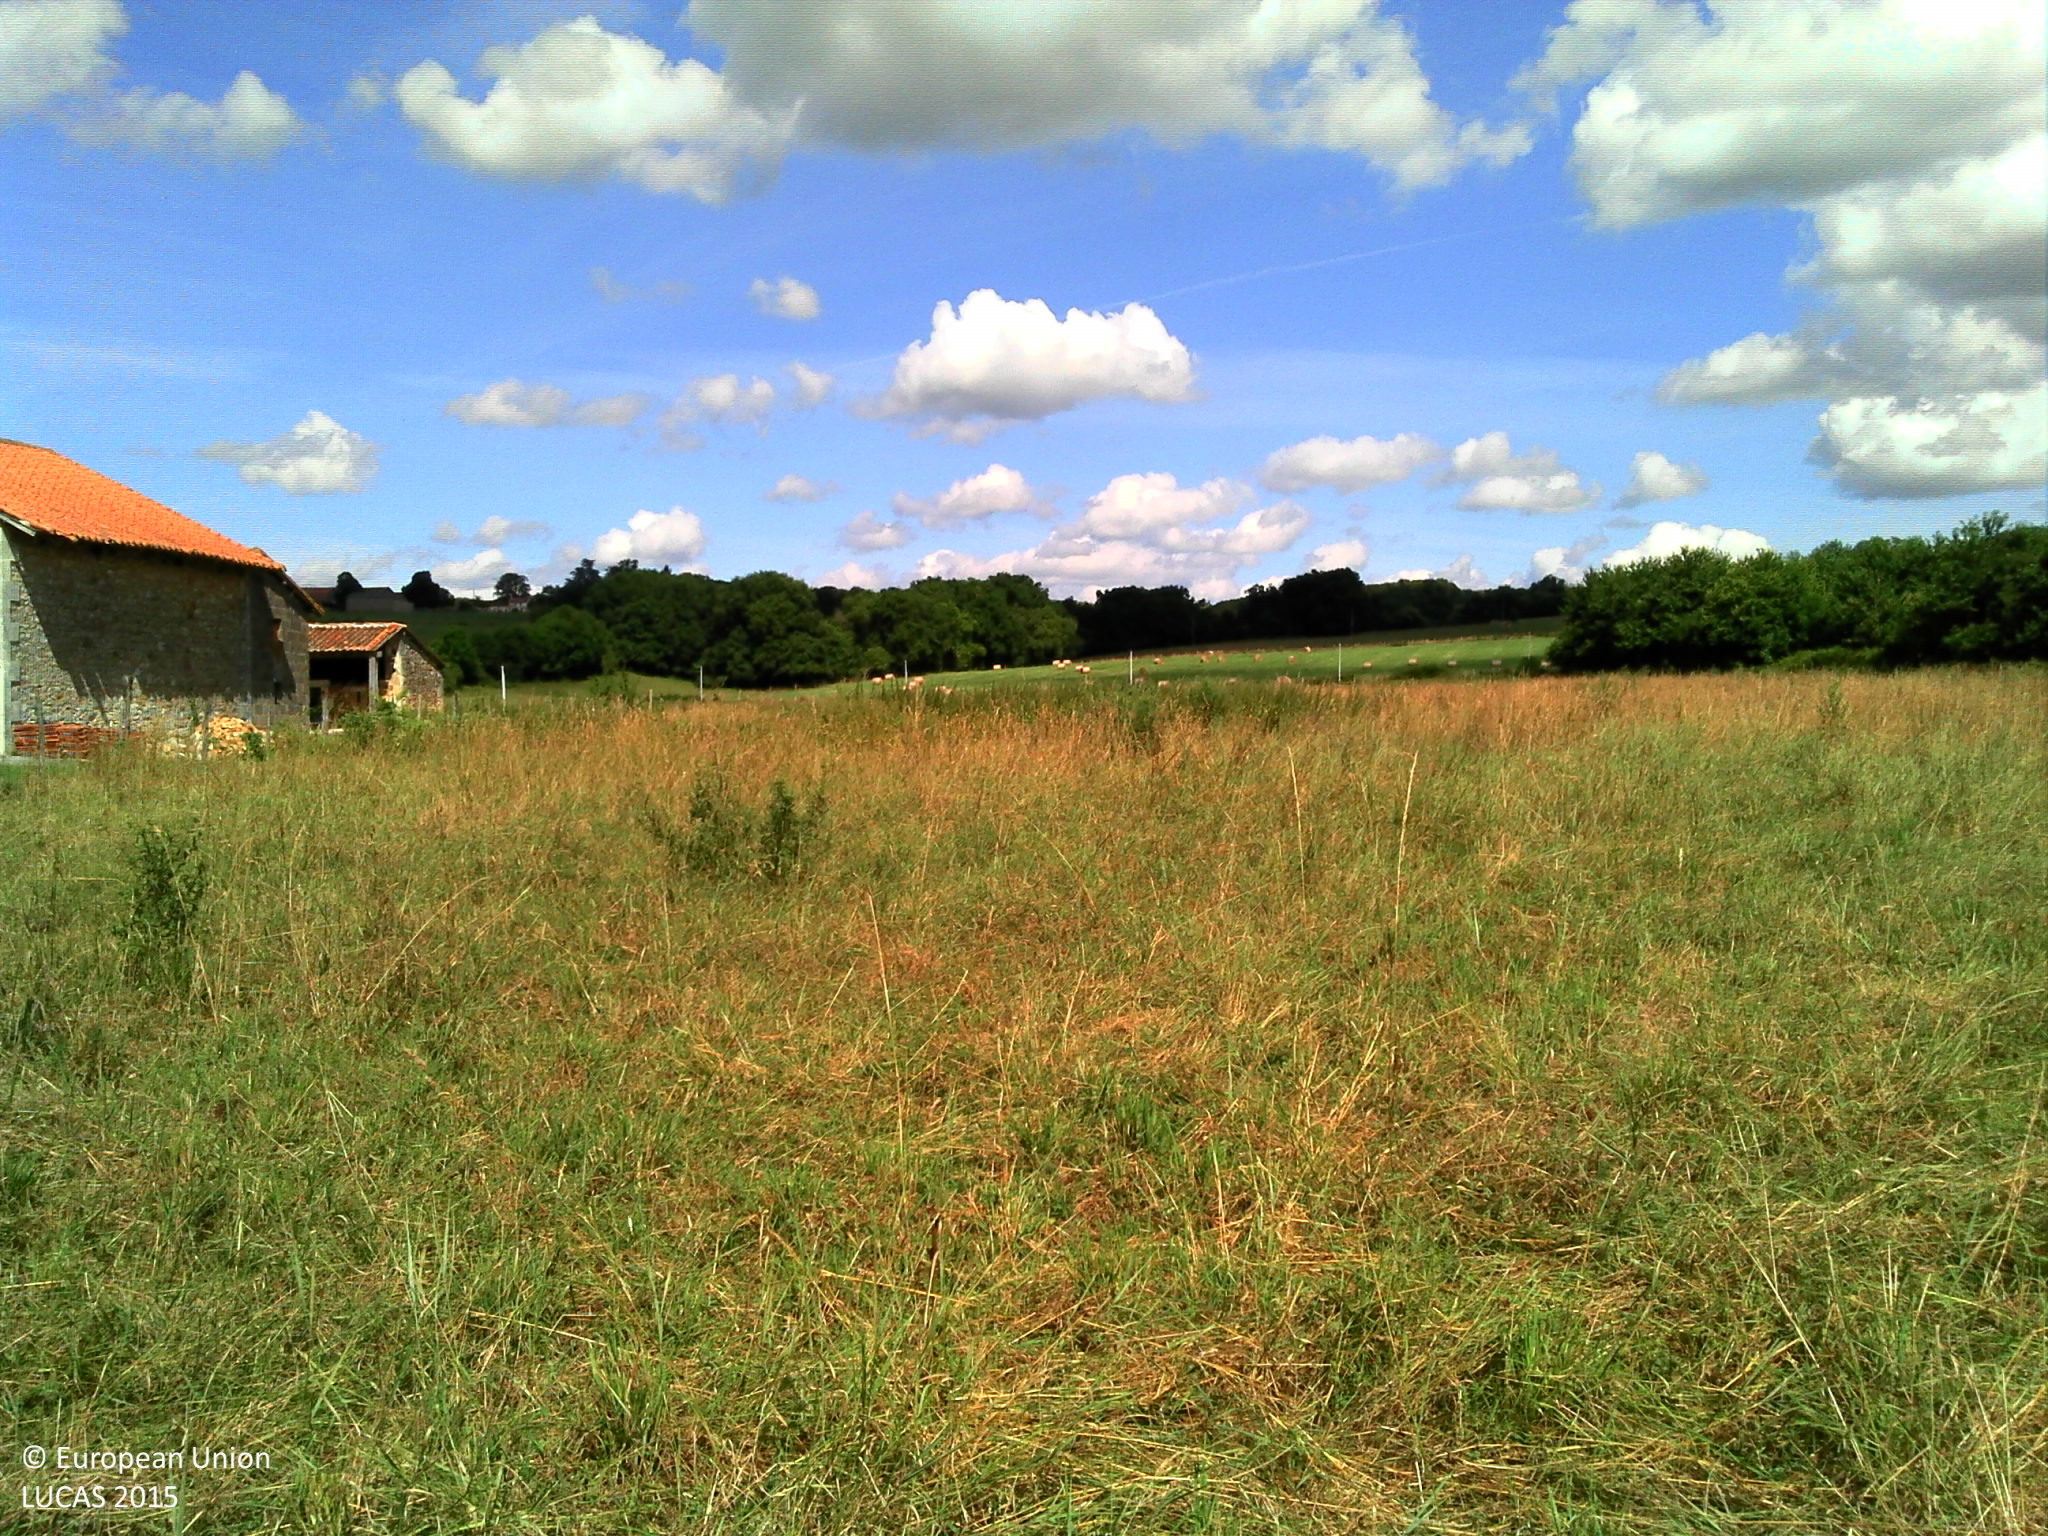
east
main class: Grassland
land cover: Grassland without tree/shrub cover
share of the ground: > 75 %
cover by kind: herbaceous plants 100 %
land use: Agriculture (excluding fallow land and kitchen gardens)
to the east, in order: Grassland without tree/shrub cover; Fences; Grass margins; Paved roads, cycling and walking lanes; Grass margins; Fences; Grassland without tree/shrub cover
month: June
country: FR
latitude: 45.7047
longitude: 0.4423
